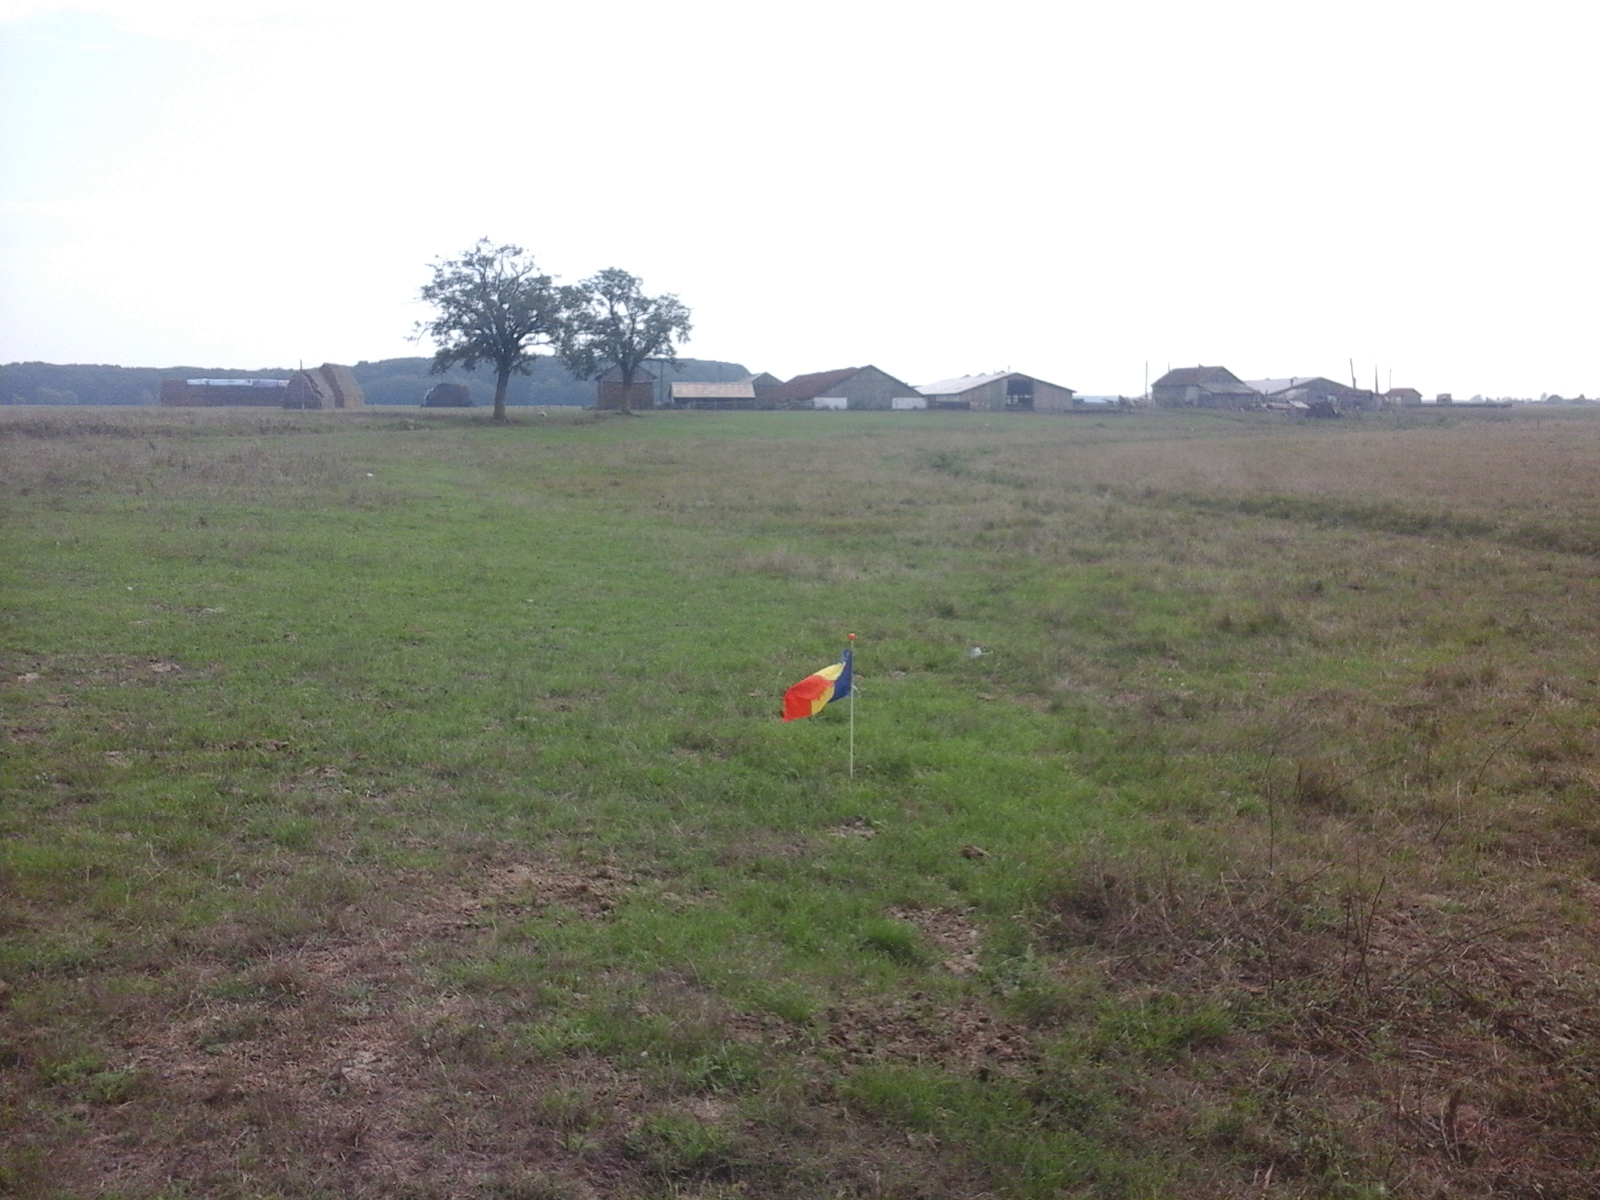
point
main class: Grassland
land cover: Grassland without tree/shrub cover
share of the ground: > 75 %
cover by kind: herbaceous plants 100 %
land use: Agriculture (excluding fallow land and kitchen gardens)
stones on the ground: < 10 %
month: August
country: RO
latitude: 46.5768
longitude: 21.5609
